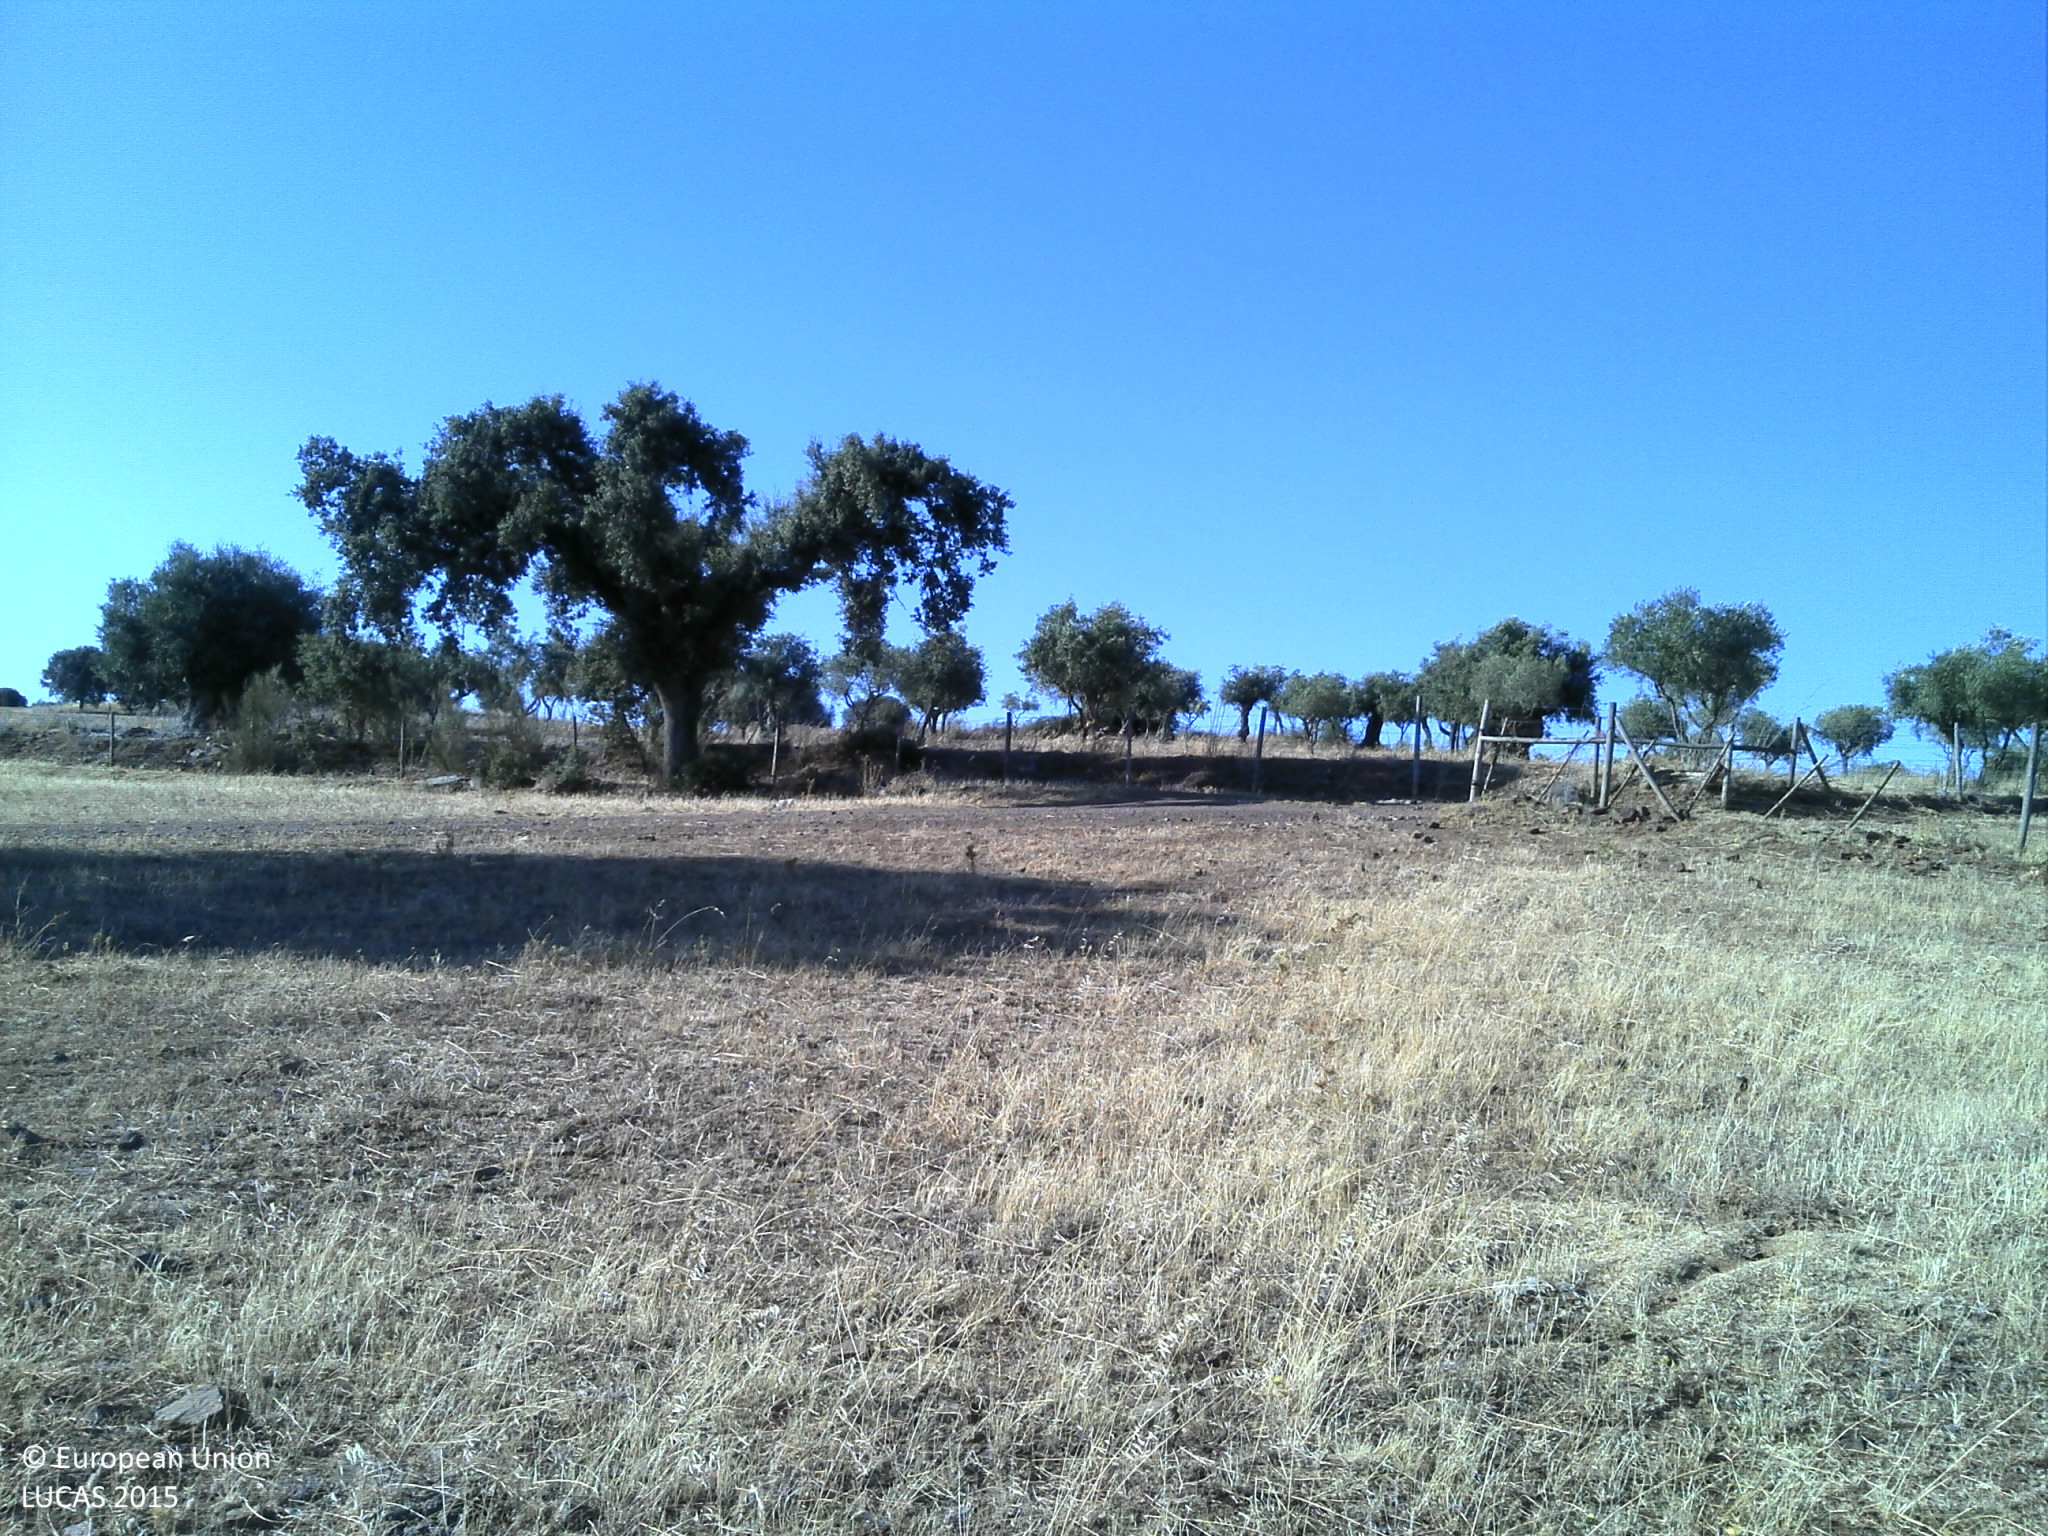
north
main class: Grassland
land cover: Grassland without tree/shrub cover
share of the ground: 25 - 50 %
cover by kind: unconsolidated bare surface 75 %, herbaceous plants 25 %
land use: Agriculture (excluding fallow land and kitchen gardens)
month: July
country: PT
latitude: 38.9716
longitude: -7.5241
